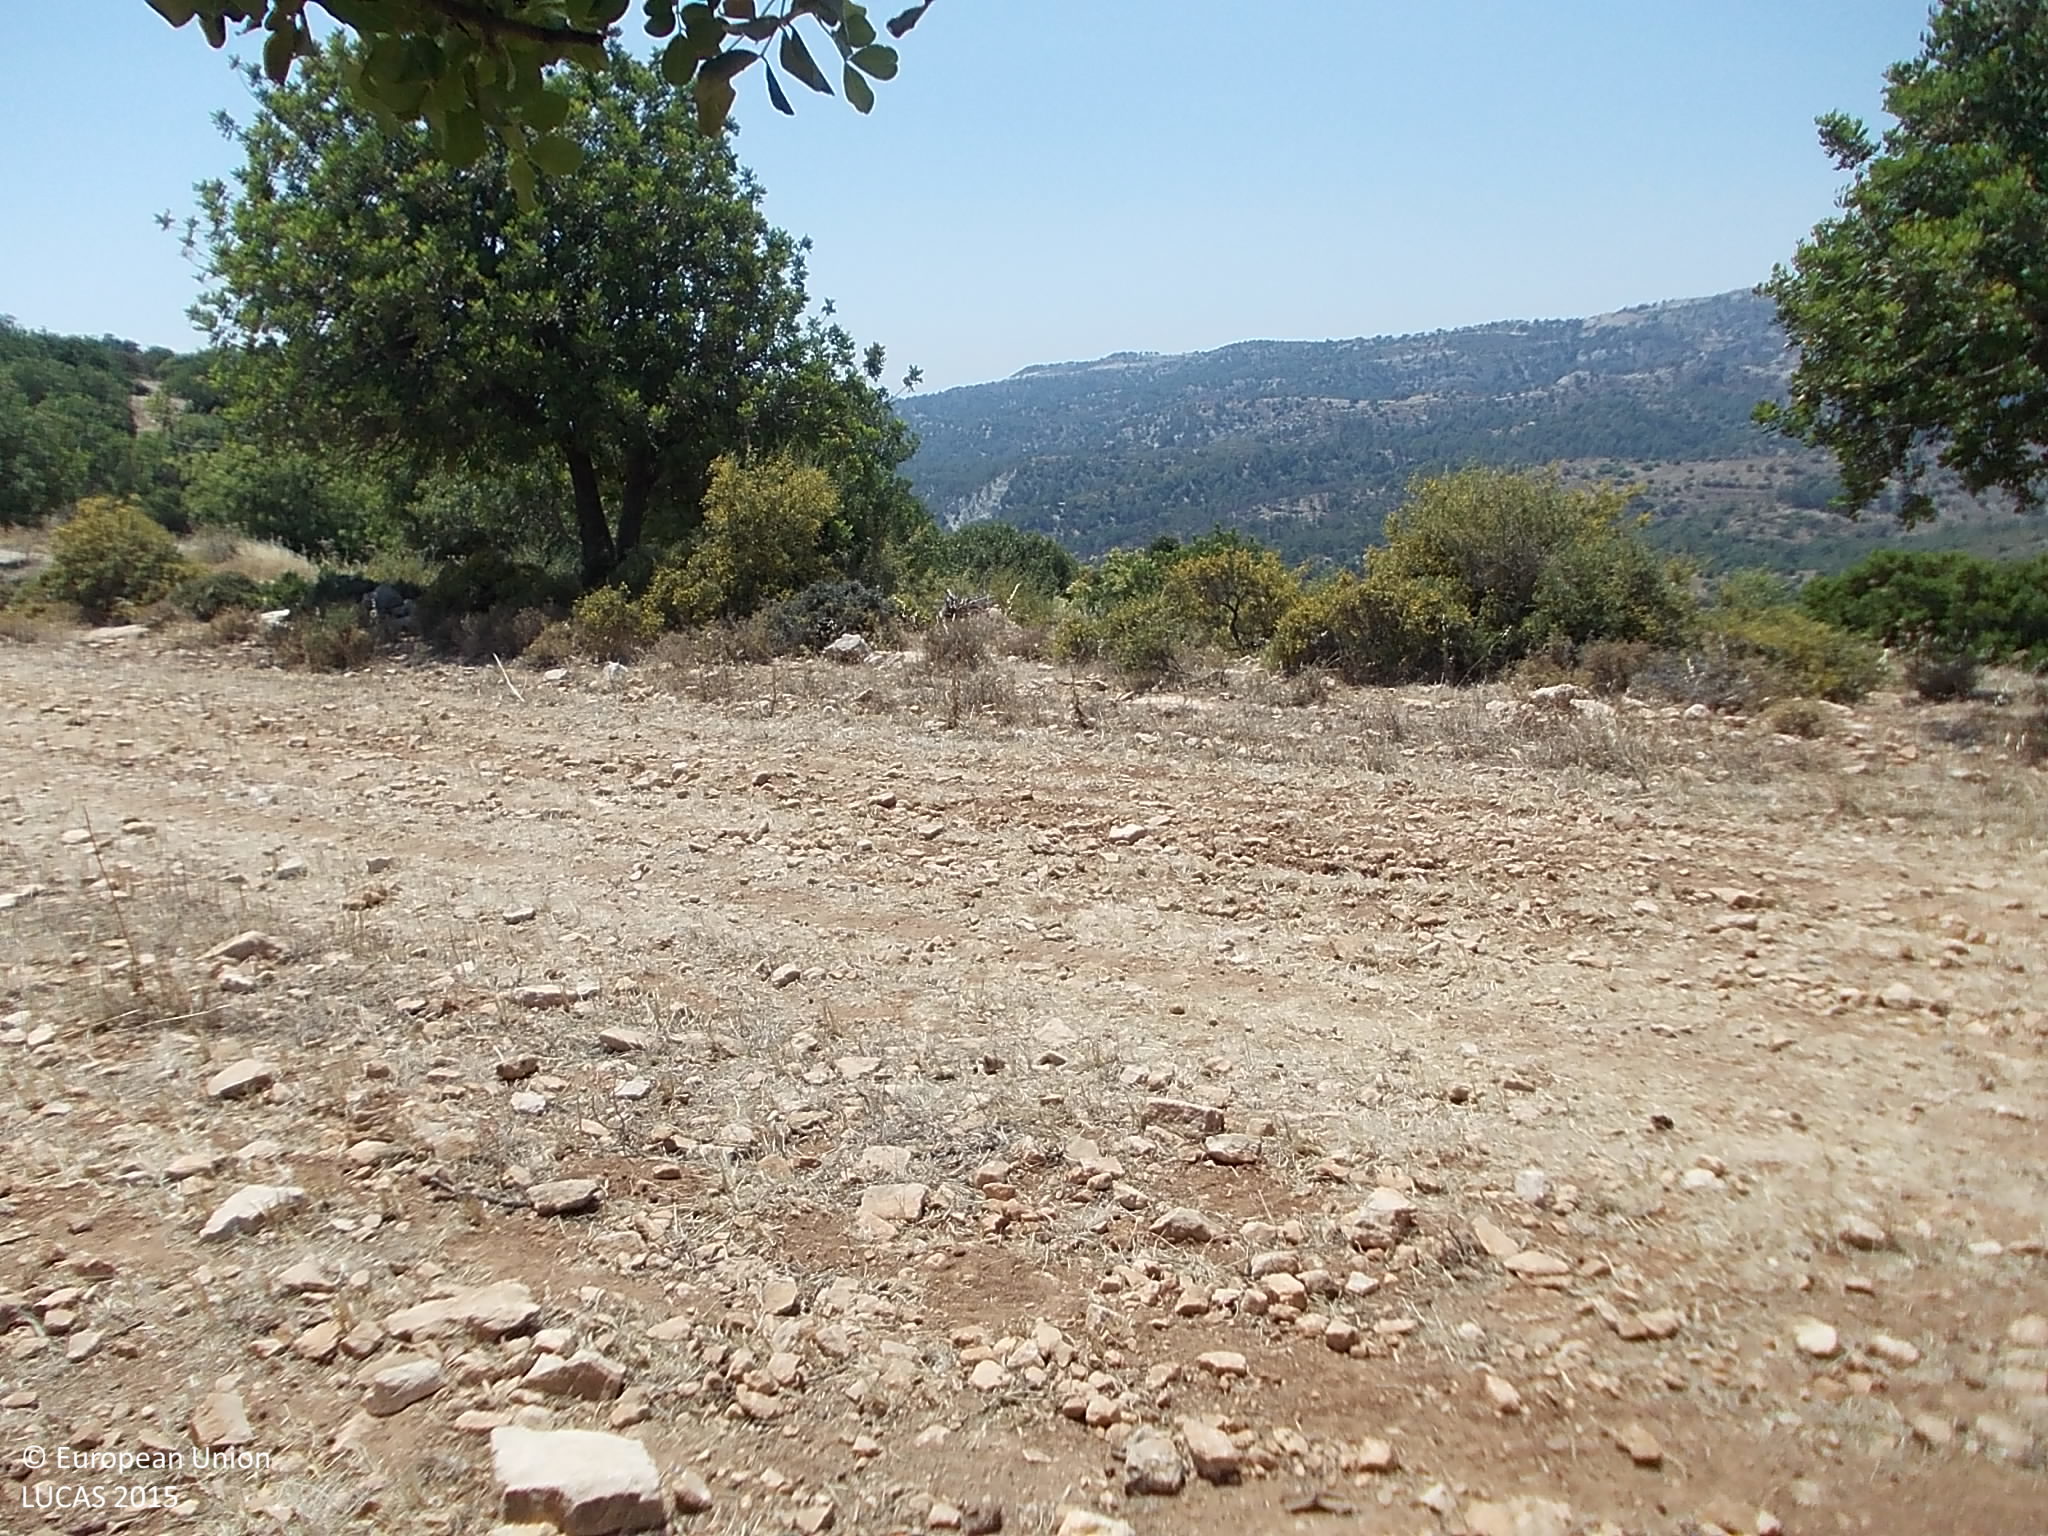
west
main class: Cropland
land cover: Nuts trees
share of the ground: 10 - 25 %
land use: Agriculture (excluding fallow land and kitchen gardens)
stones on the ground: 25 - 50 %
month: July
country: CY
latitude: 34.7491
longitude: 32.7342
